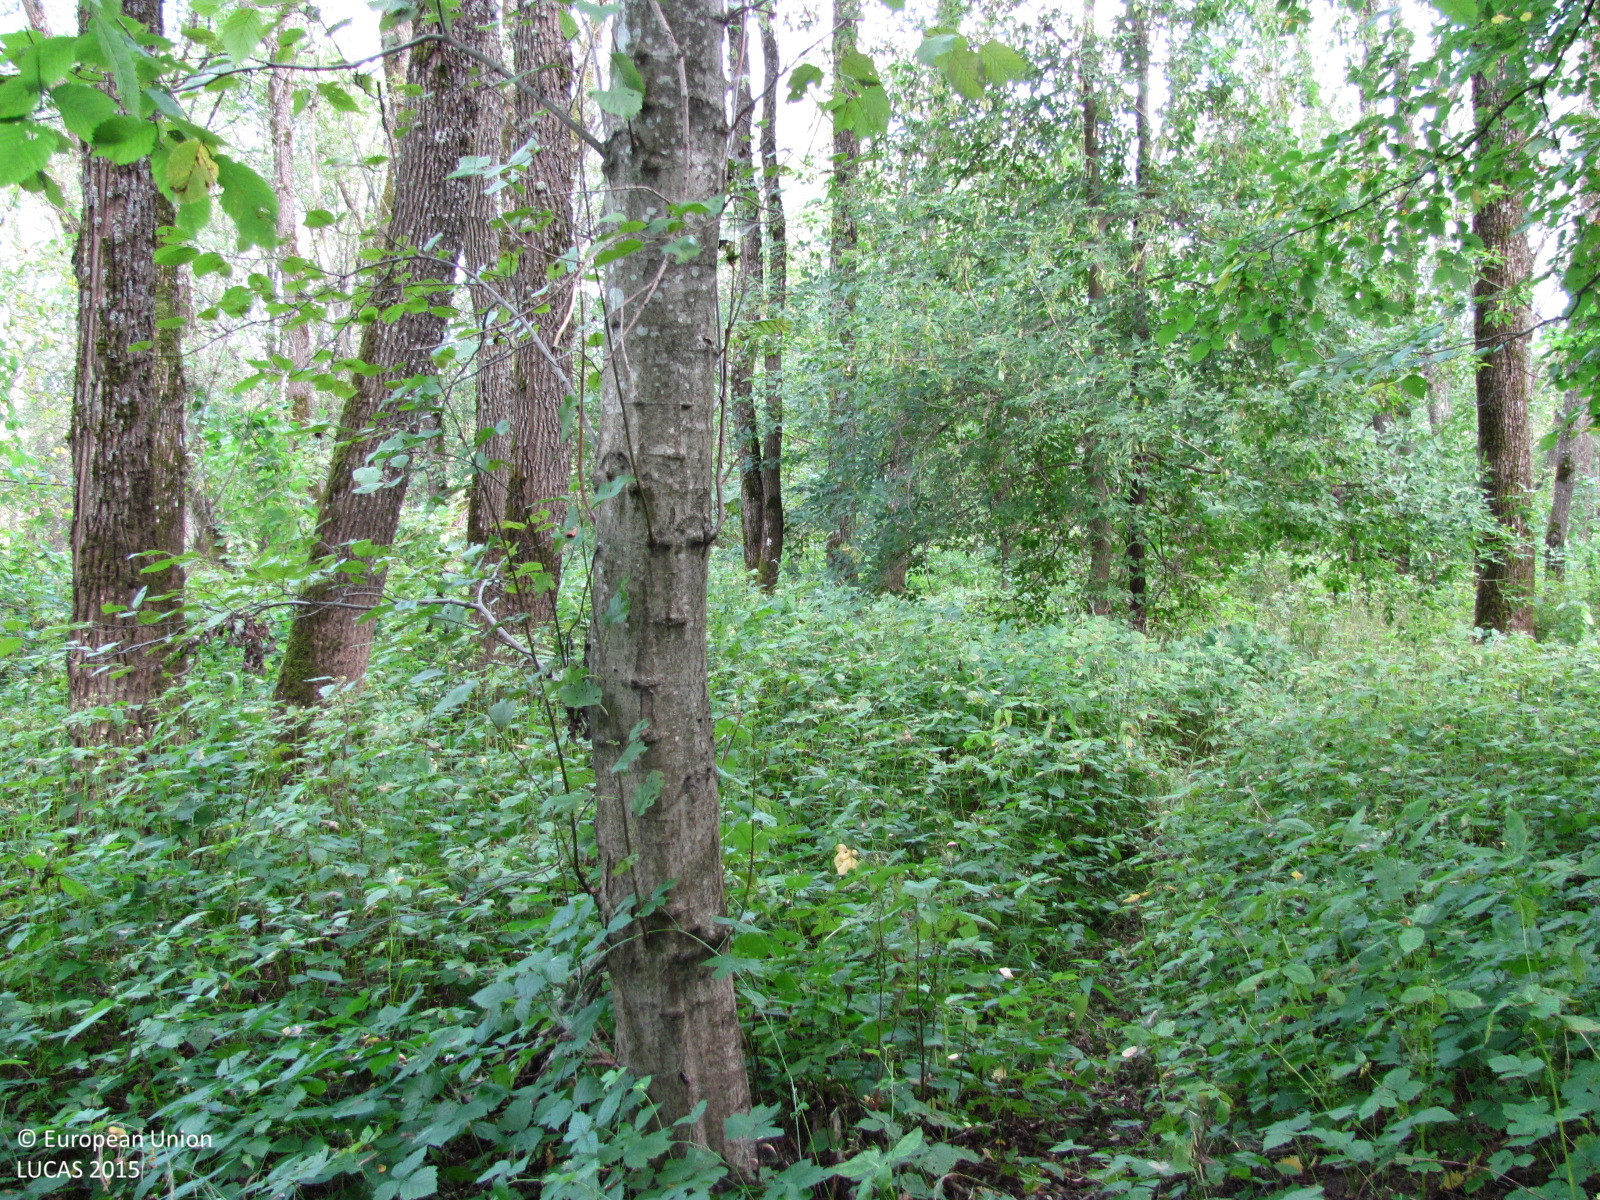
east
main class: Woodland
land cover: Broadleaved woodland
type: floodplain forest
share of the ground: > 75 %
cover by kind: broadleaved forest trees 80 %, herbaceous plants 15 %, unconsolidated bare surface 5 %
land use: Semi-natural and natural areas not in use
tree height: > 5 m
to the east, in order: Broadleaved woodland; Inland fresh running water; Broadleaved woodland
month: September
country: LV
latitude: 57.0975
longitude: 24.3341
